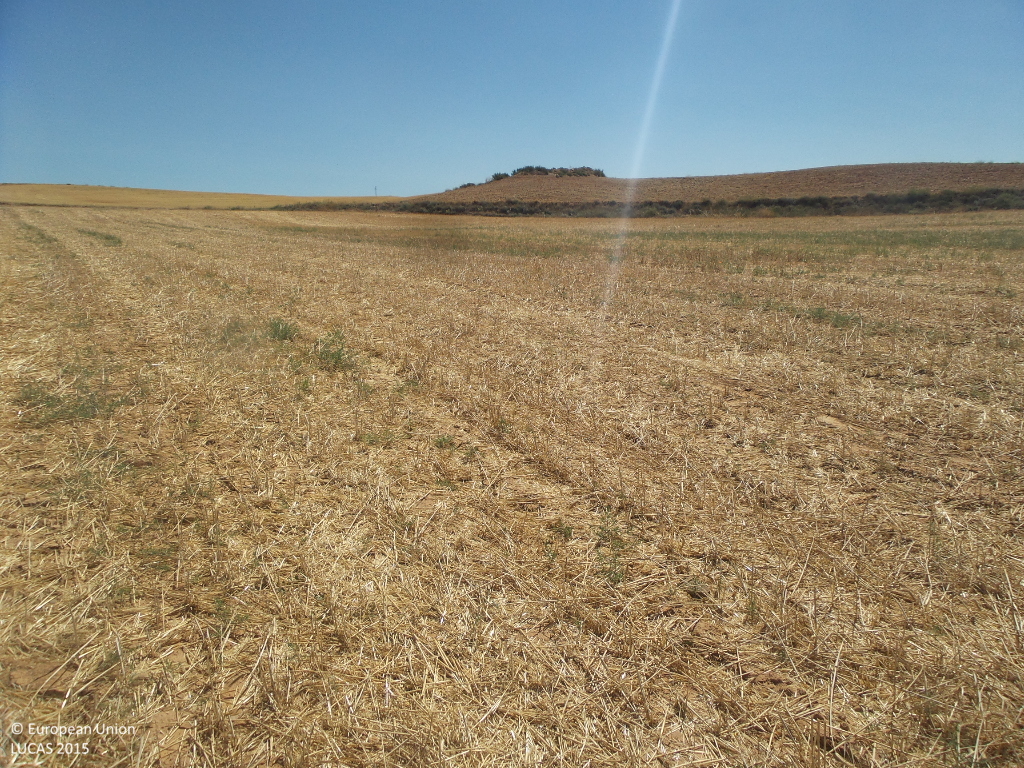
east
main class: Cropland
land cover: Common wheat
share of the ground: < 10 %
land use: Agriculture (excluding fallow land and kitchen gardens)
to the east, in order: Common wheat; Shruby margins; Other bare soil; Grass margins; Barley; Tracks; Barley
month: July
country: ES
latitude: 41.3405
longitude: -2.1113
